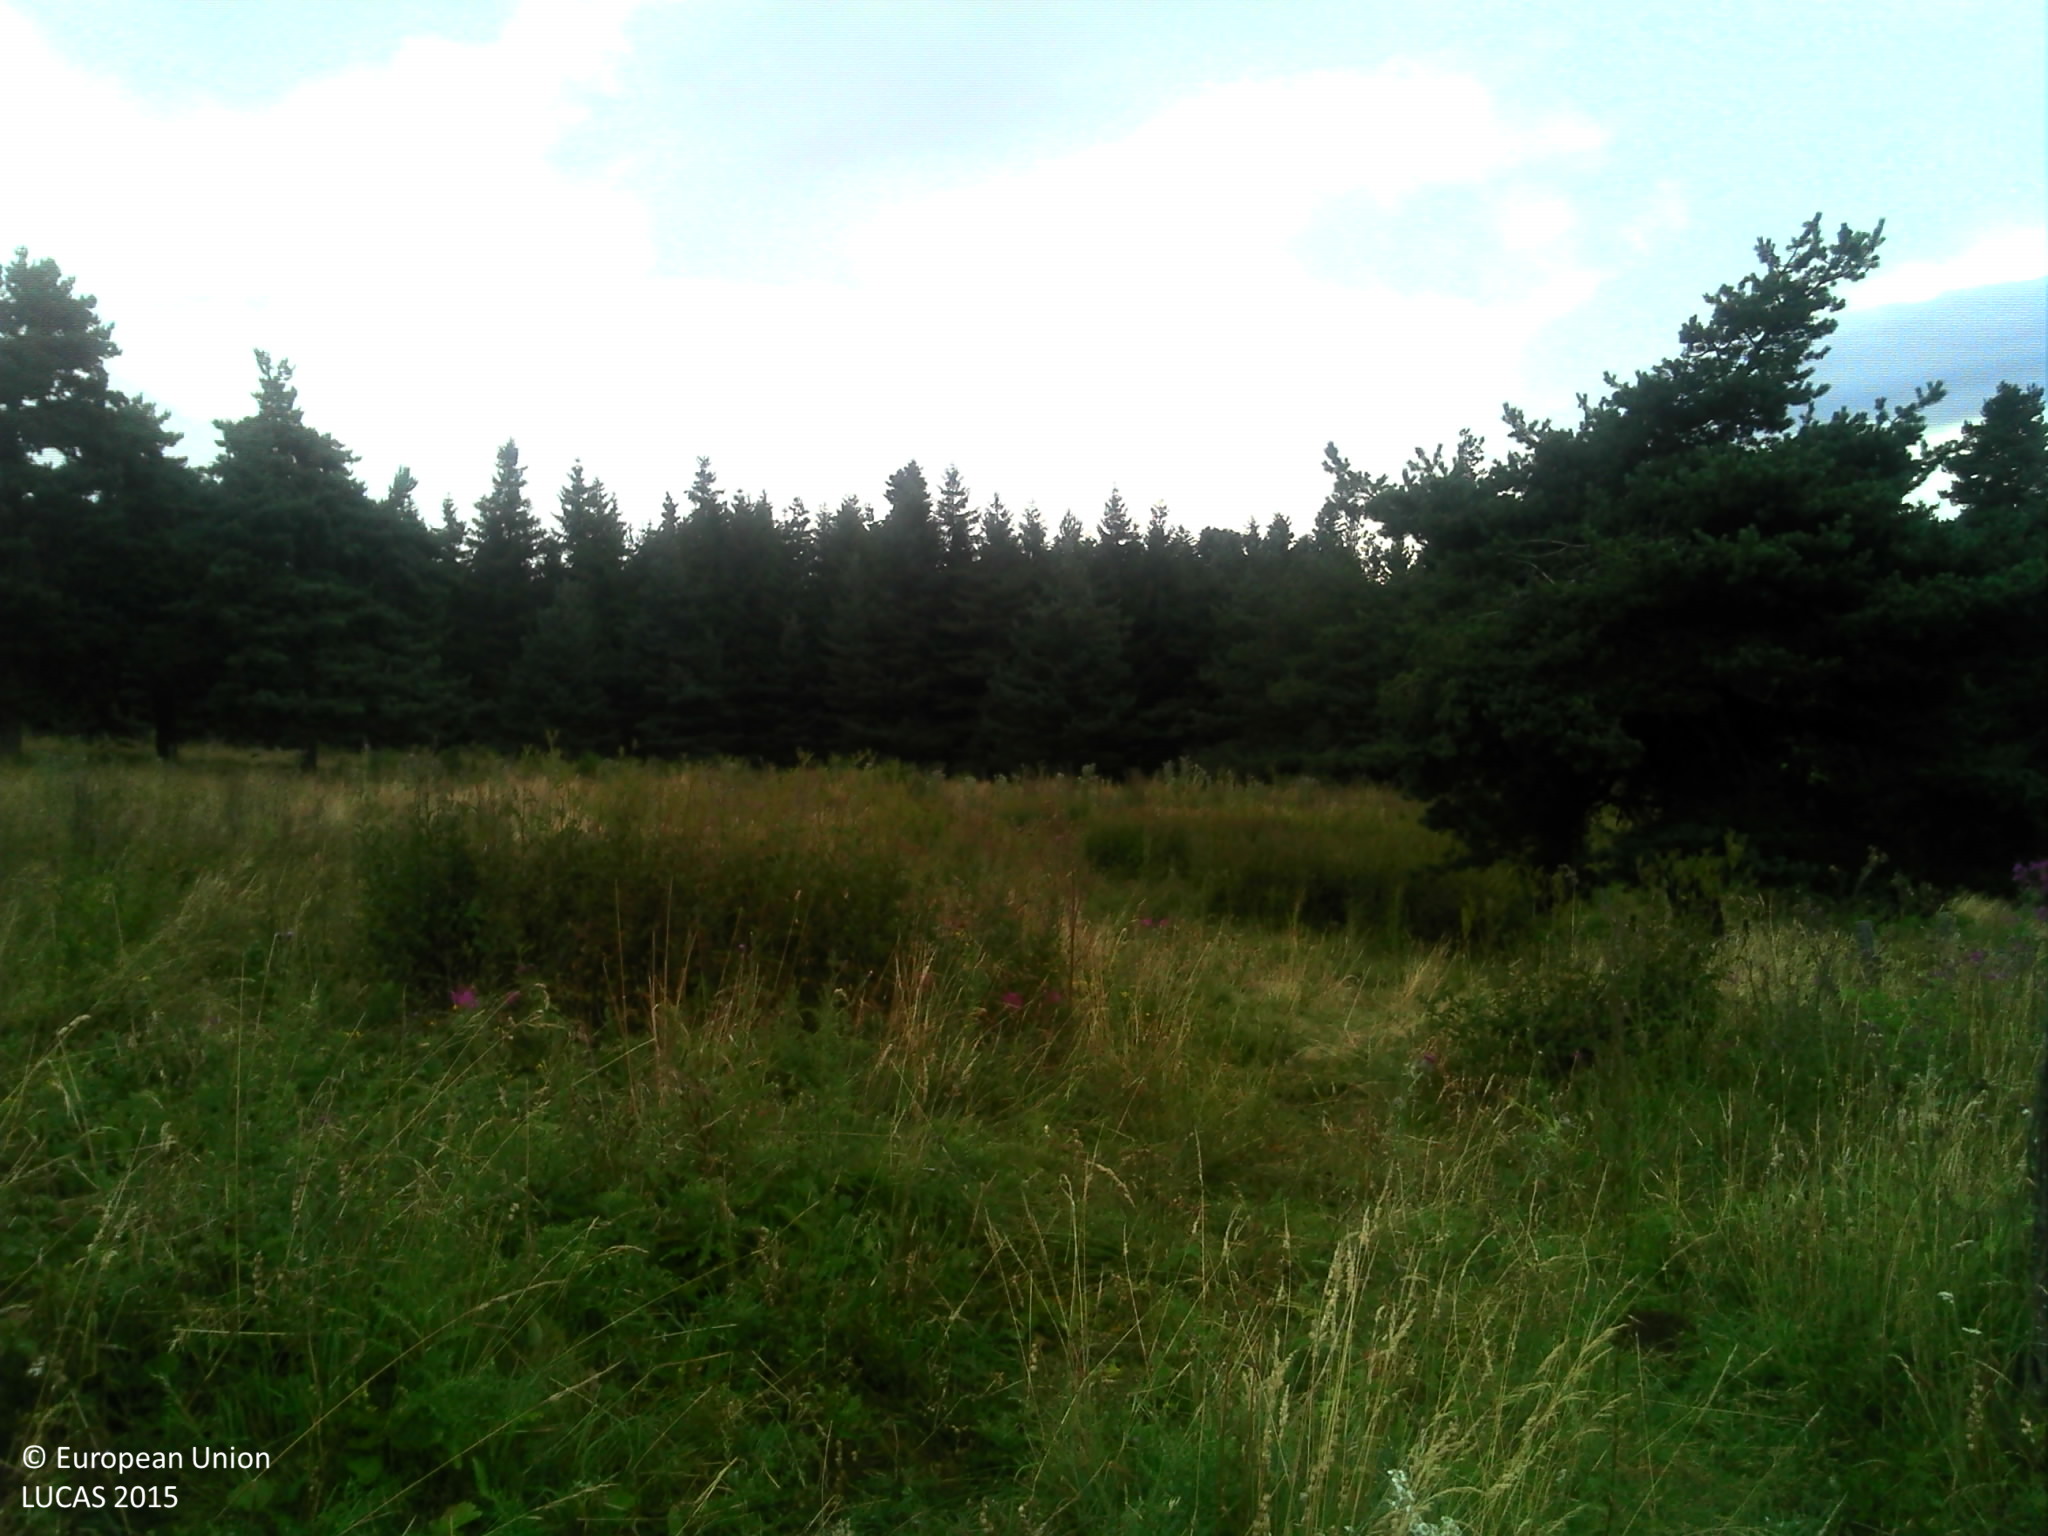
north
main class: Grassland
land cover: Grassland with sparse tree/shrub cover
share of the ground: > 75 %
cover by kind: herbaceous plants 85 %, shrubs 10 %, coniferous forest trees 5 %
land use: Agriculture (excluding fallow land and kitchen gardens)
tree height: > 5 m
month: August
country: FR
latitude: 45.0007
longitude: 4.1819
